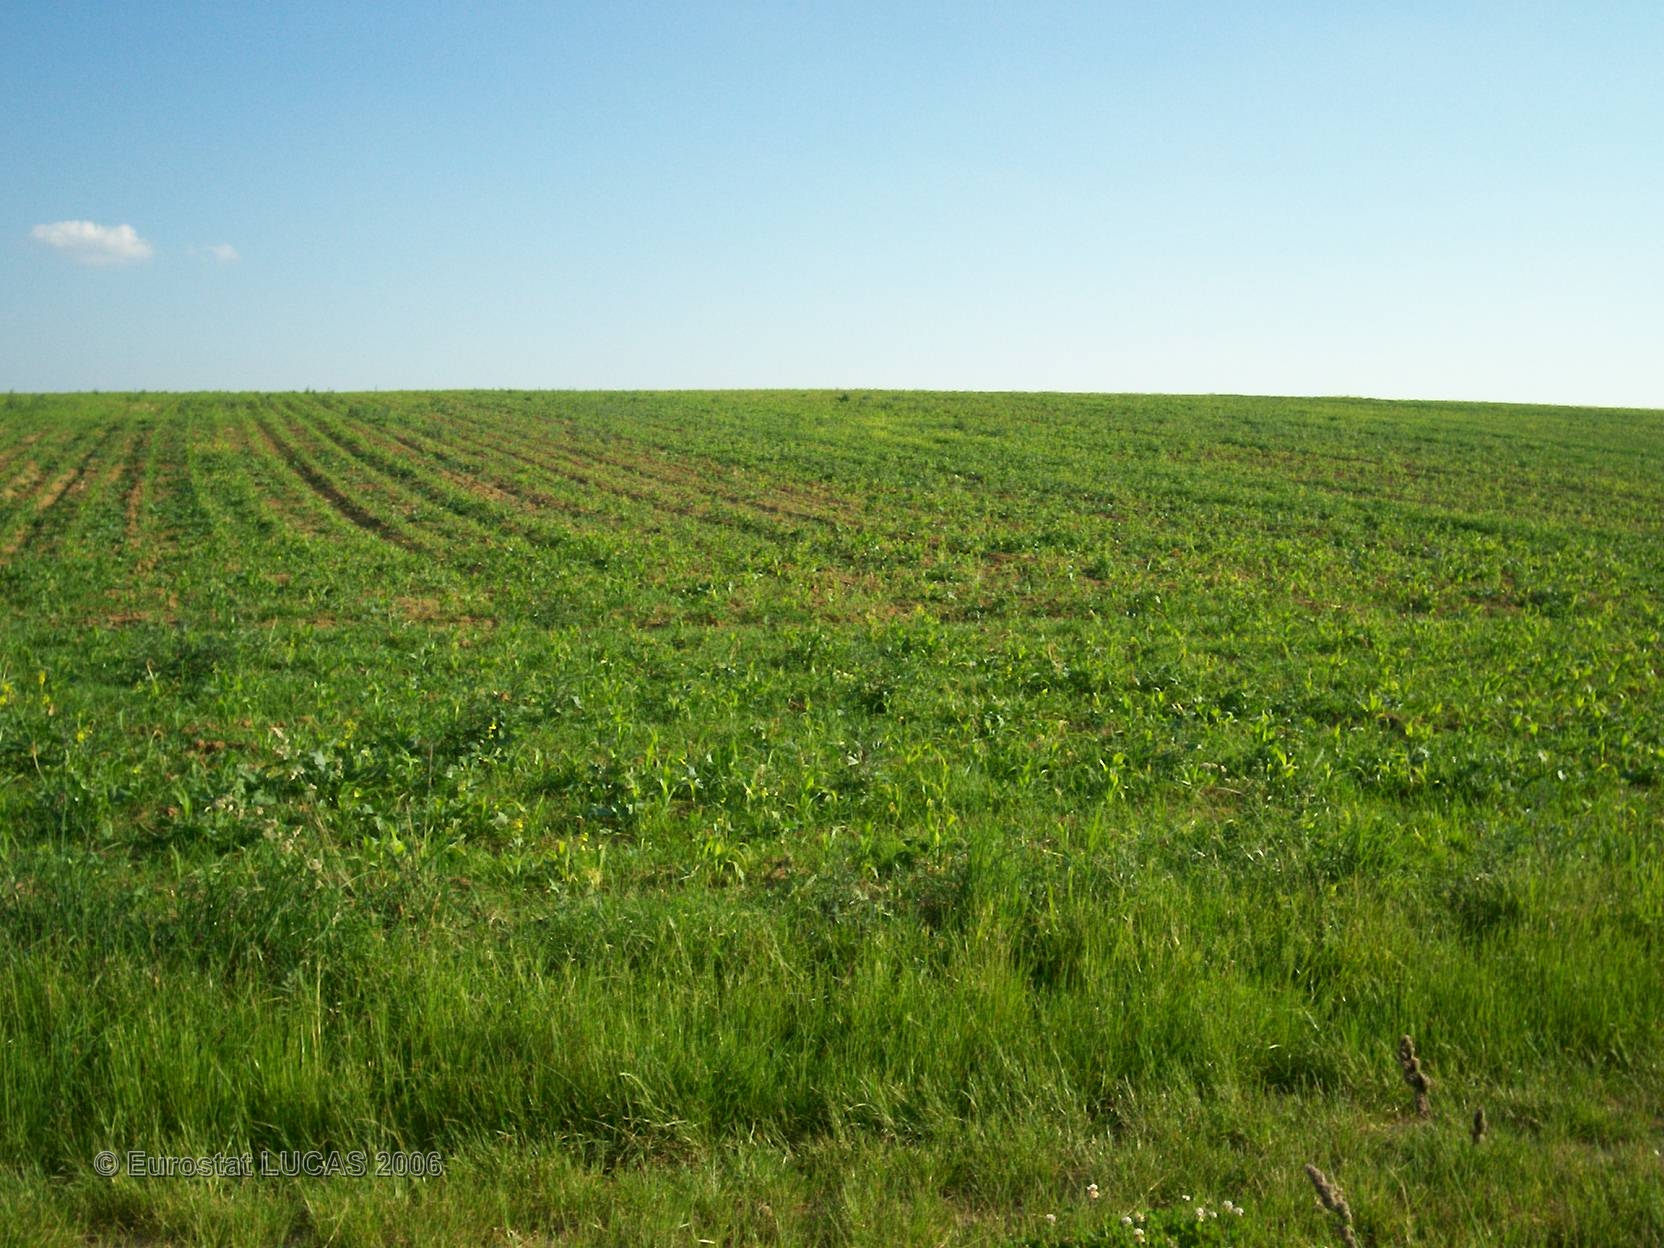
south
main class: Cropland
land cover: Rape and turnip rape
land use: Agriculture (excluding fallow land and kitchen gardens)
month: June
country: FR
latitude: 48.9313
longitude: 4.8242
